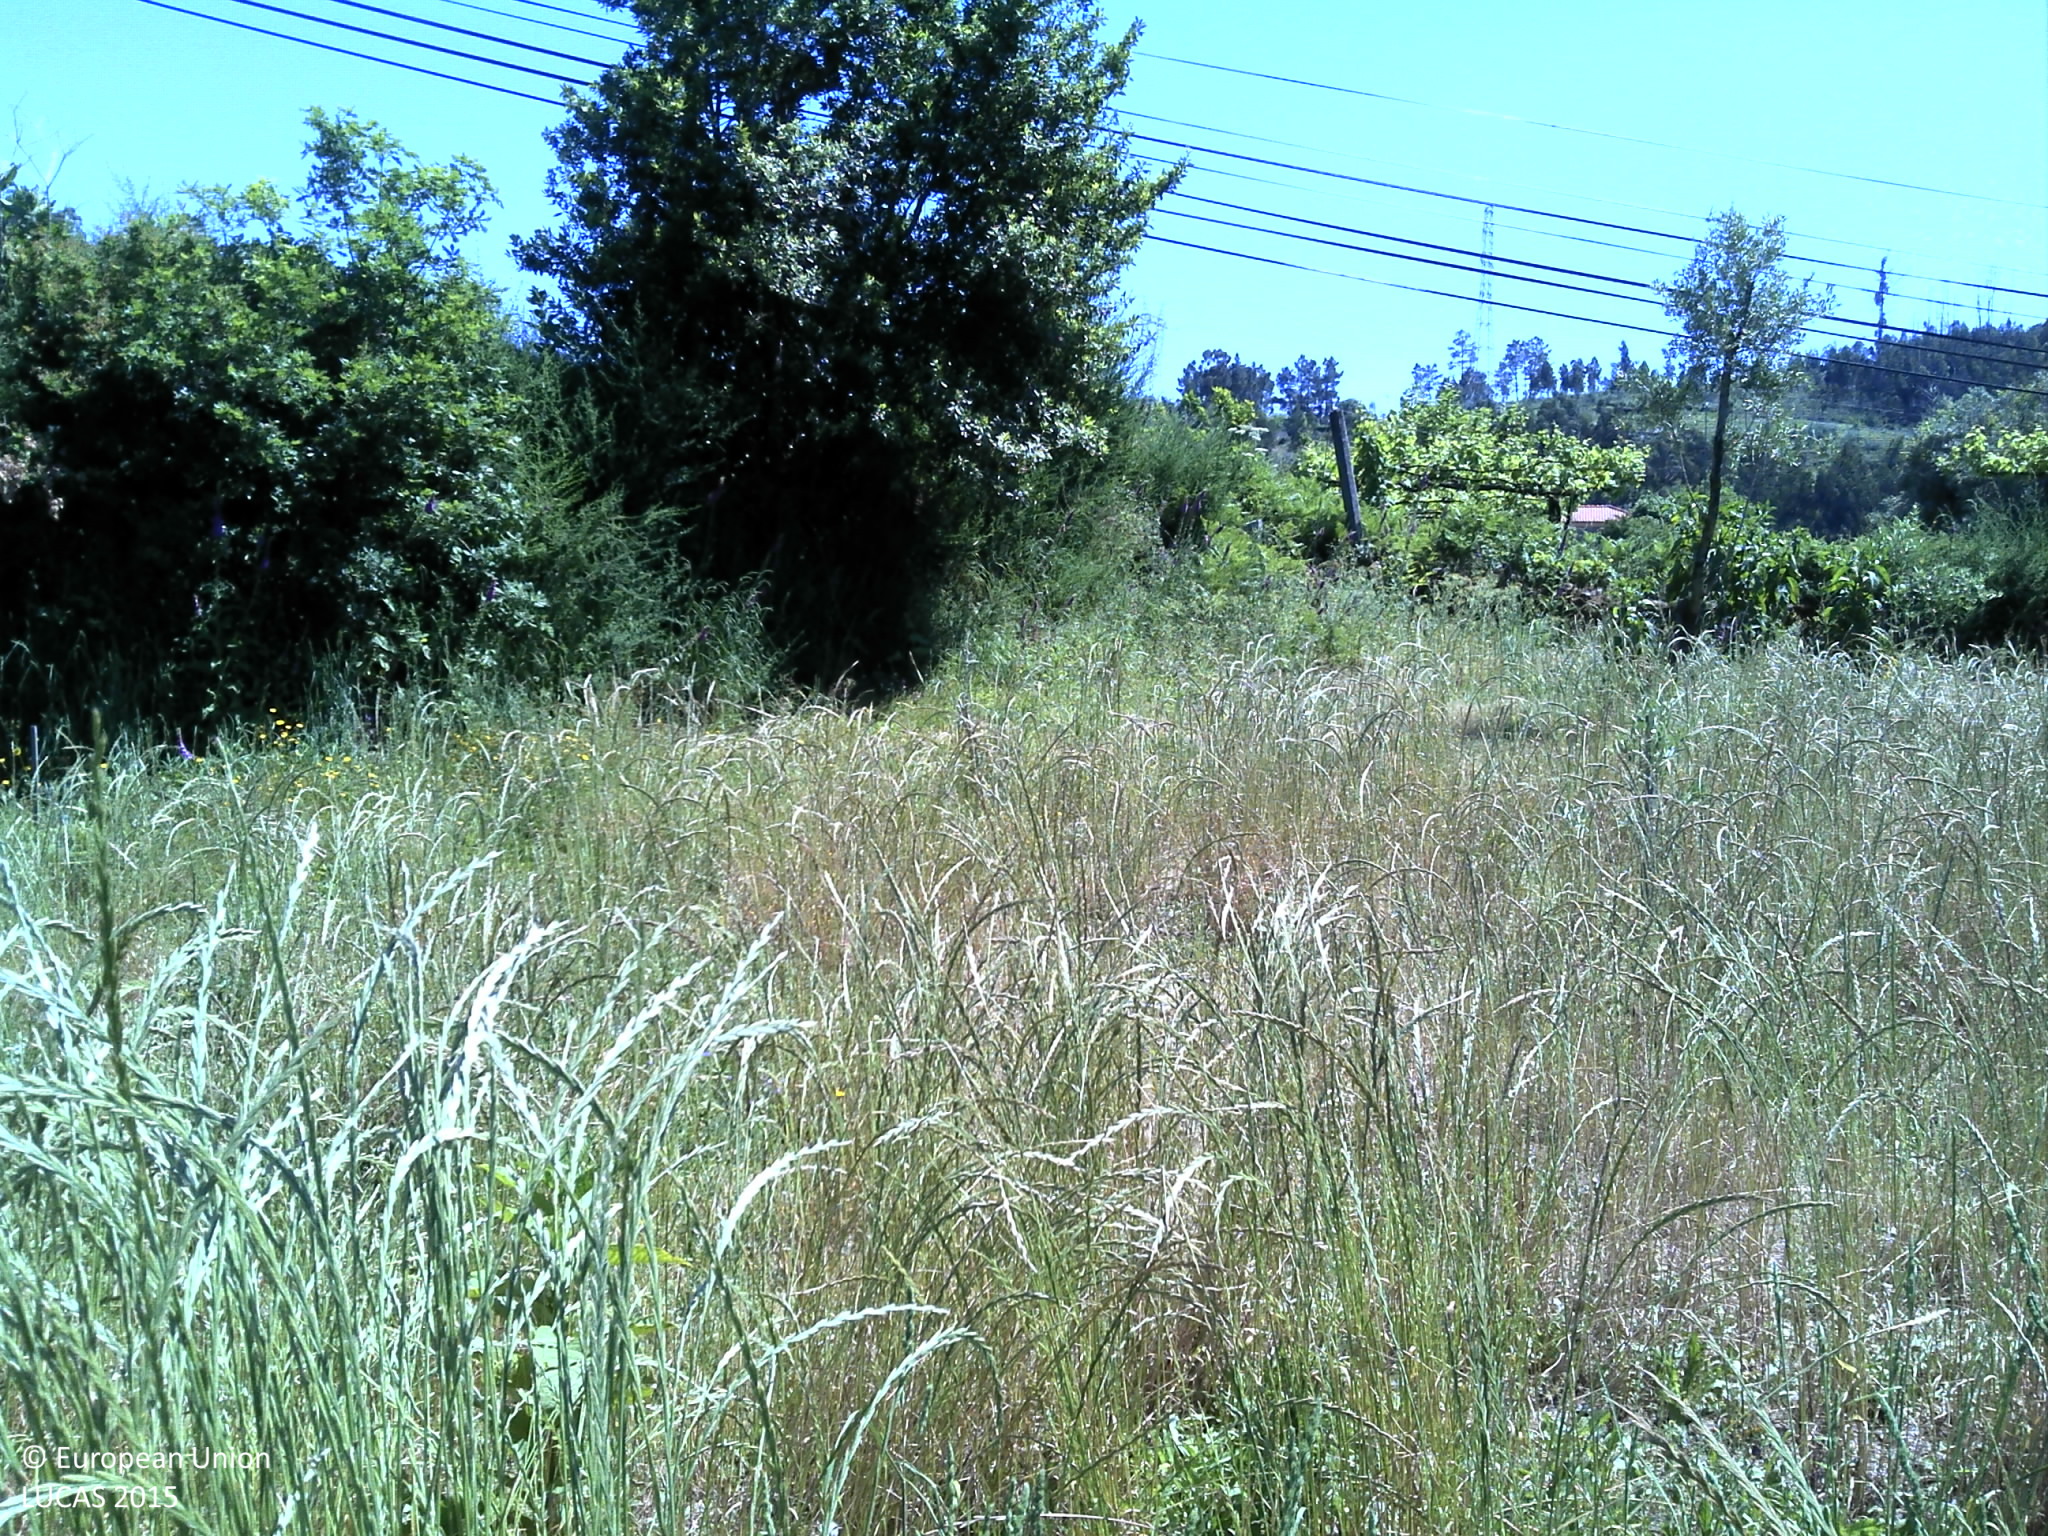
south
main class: Cropland
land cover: Olive groves
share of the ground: < 10 %
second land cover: Grassland without tree/shrub cover
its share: 50 - 75 %
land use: Agriculture (excluding fallow land and kitchen gardens)
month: May
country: PT
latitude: 41.6494
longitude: -8.6162
